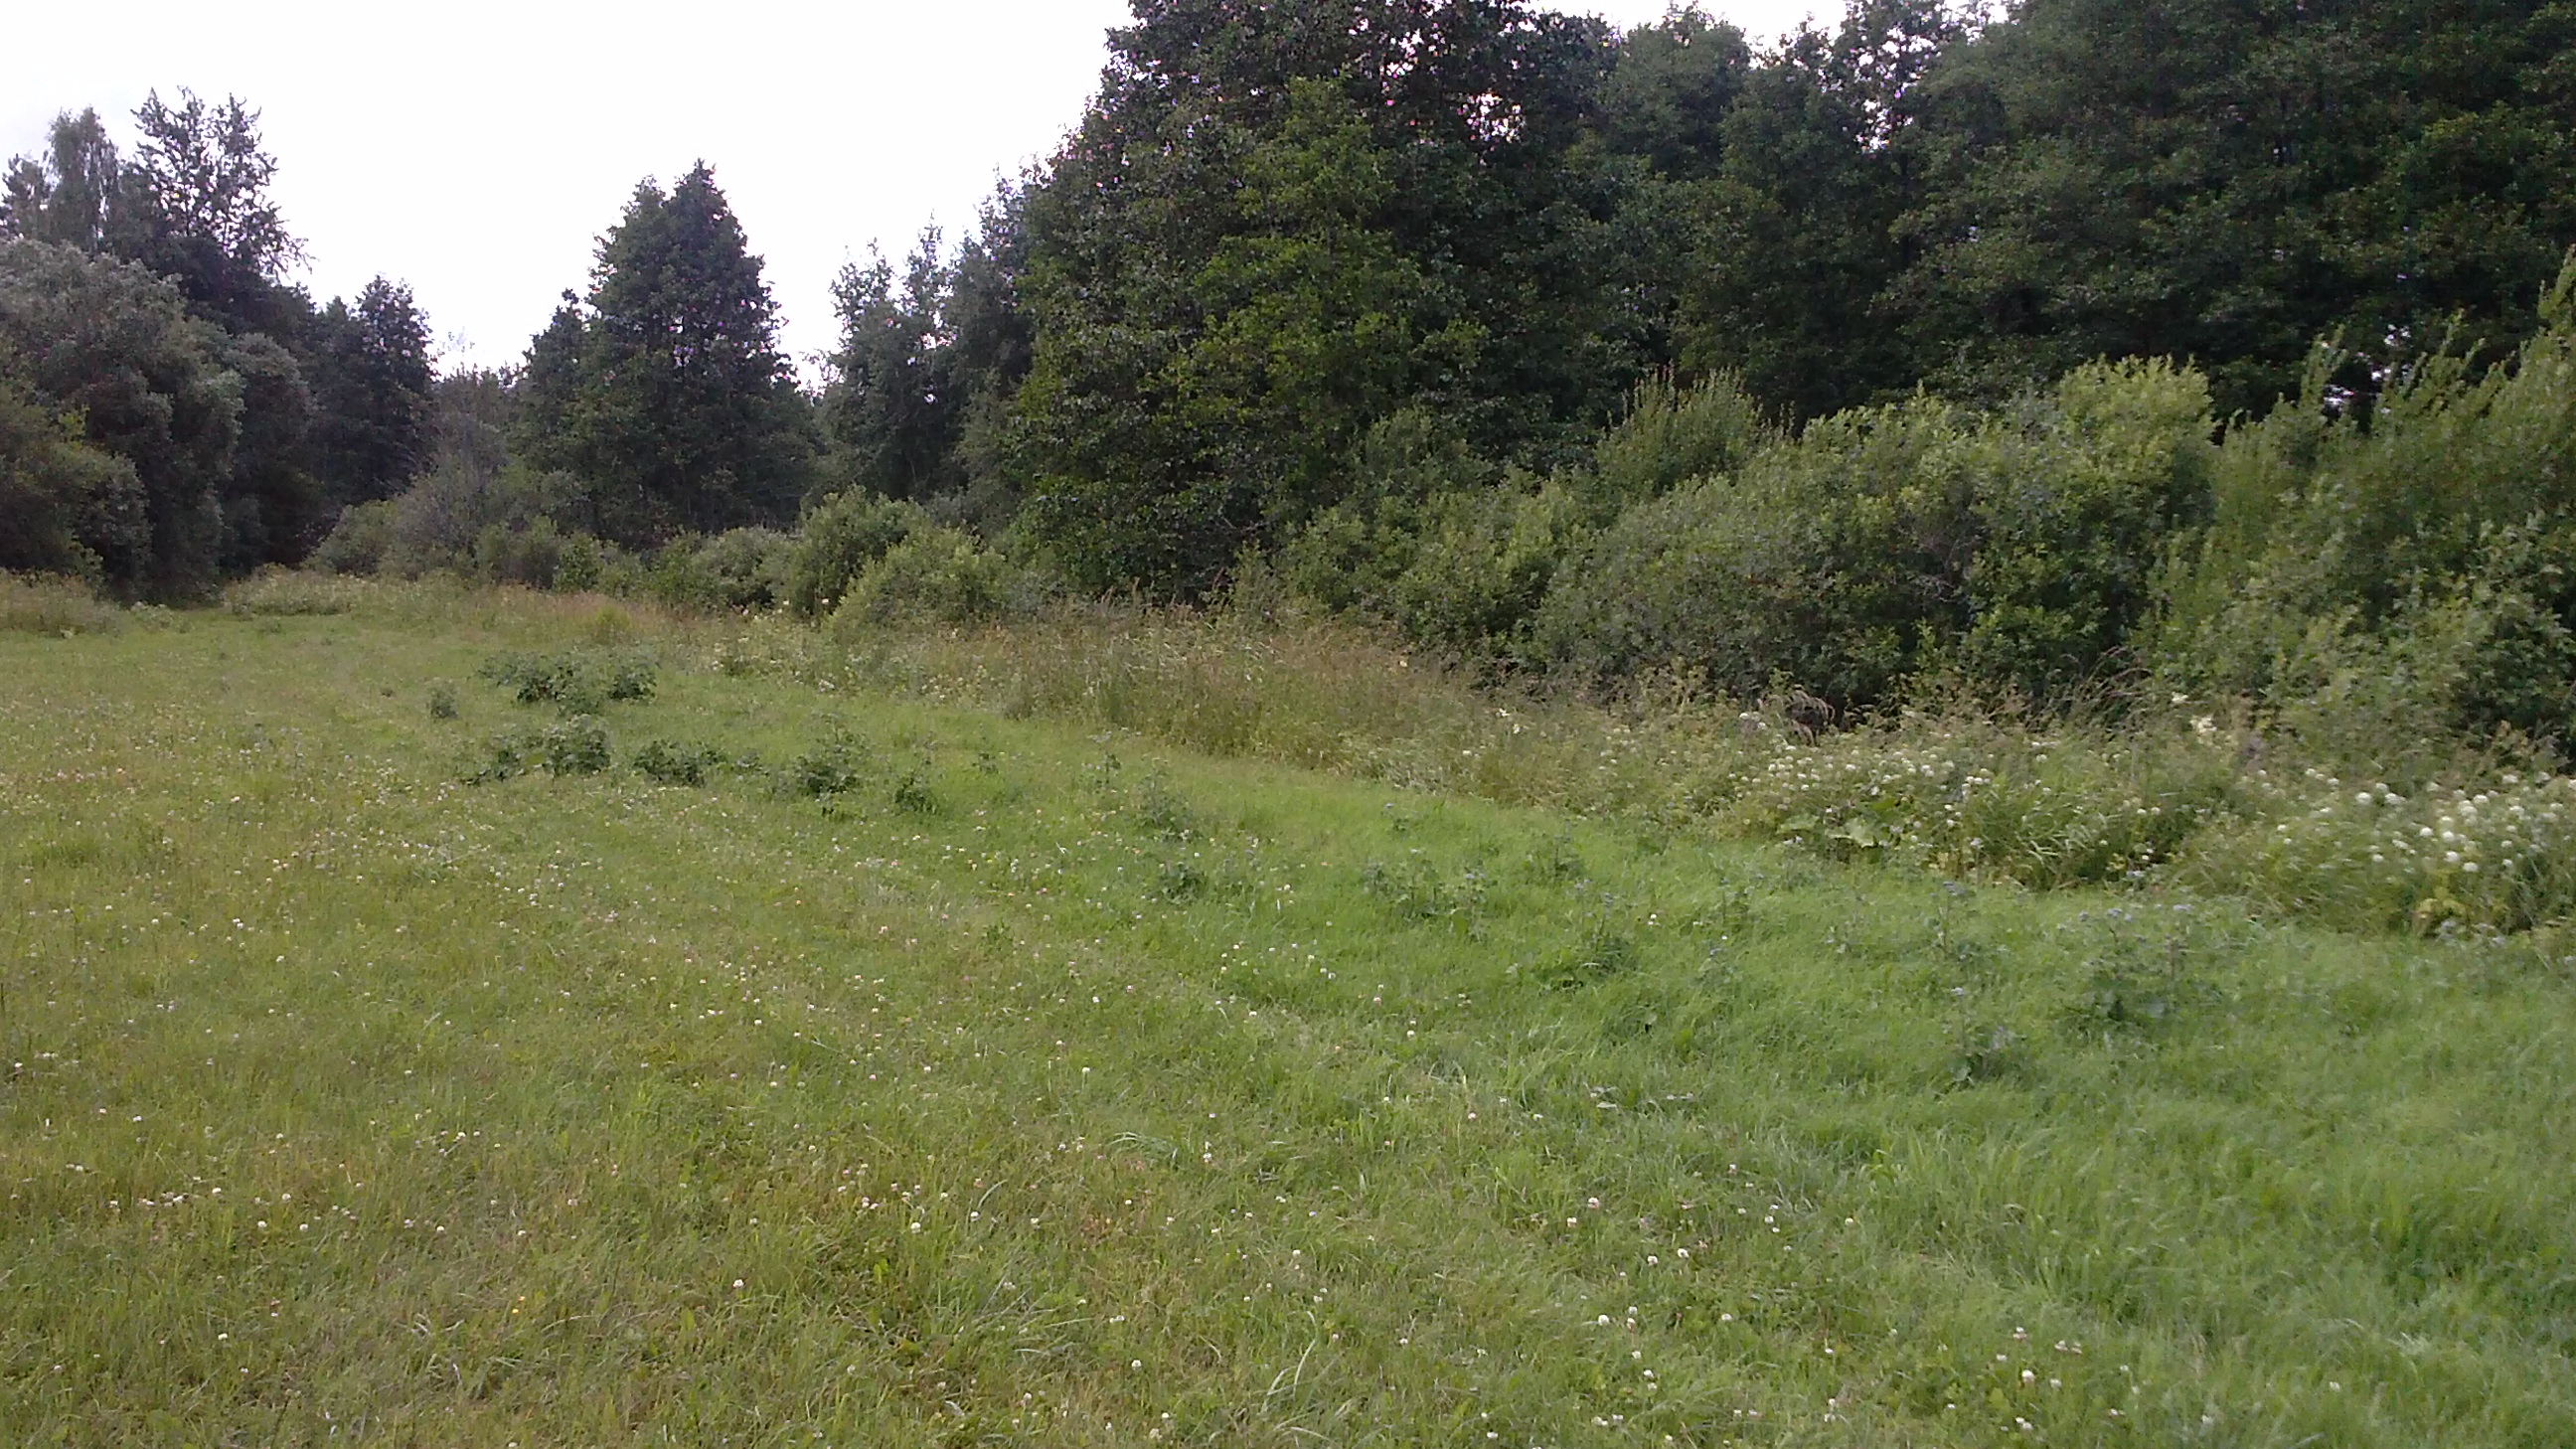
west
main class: Grassland
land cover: Grassland without tree/shrub cover
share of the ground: > 75 %
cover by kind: herbaceous plants 100 %
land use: Agriculture (excluding fallow land and kitchen gardens)
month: July
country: LV
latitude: 56.5214
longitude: 26.9524
